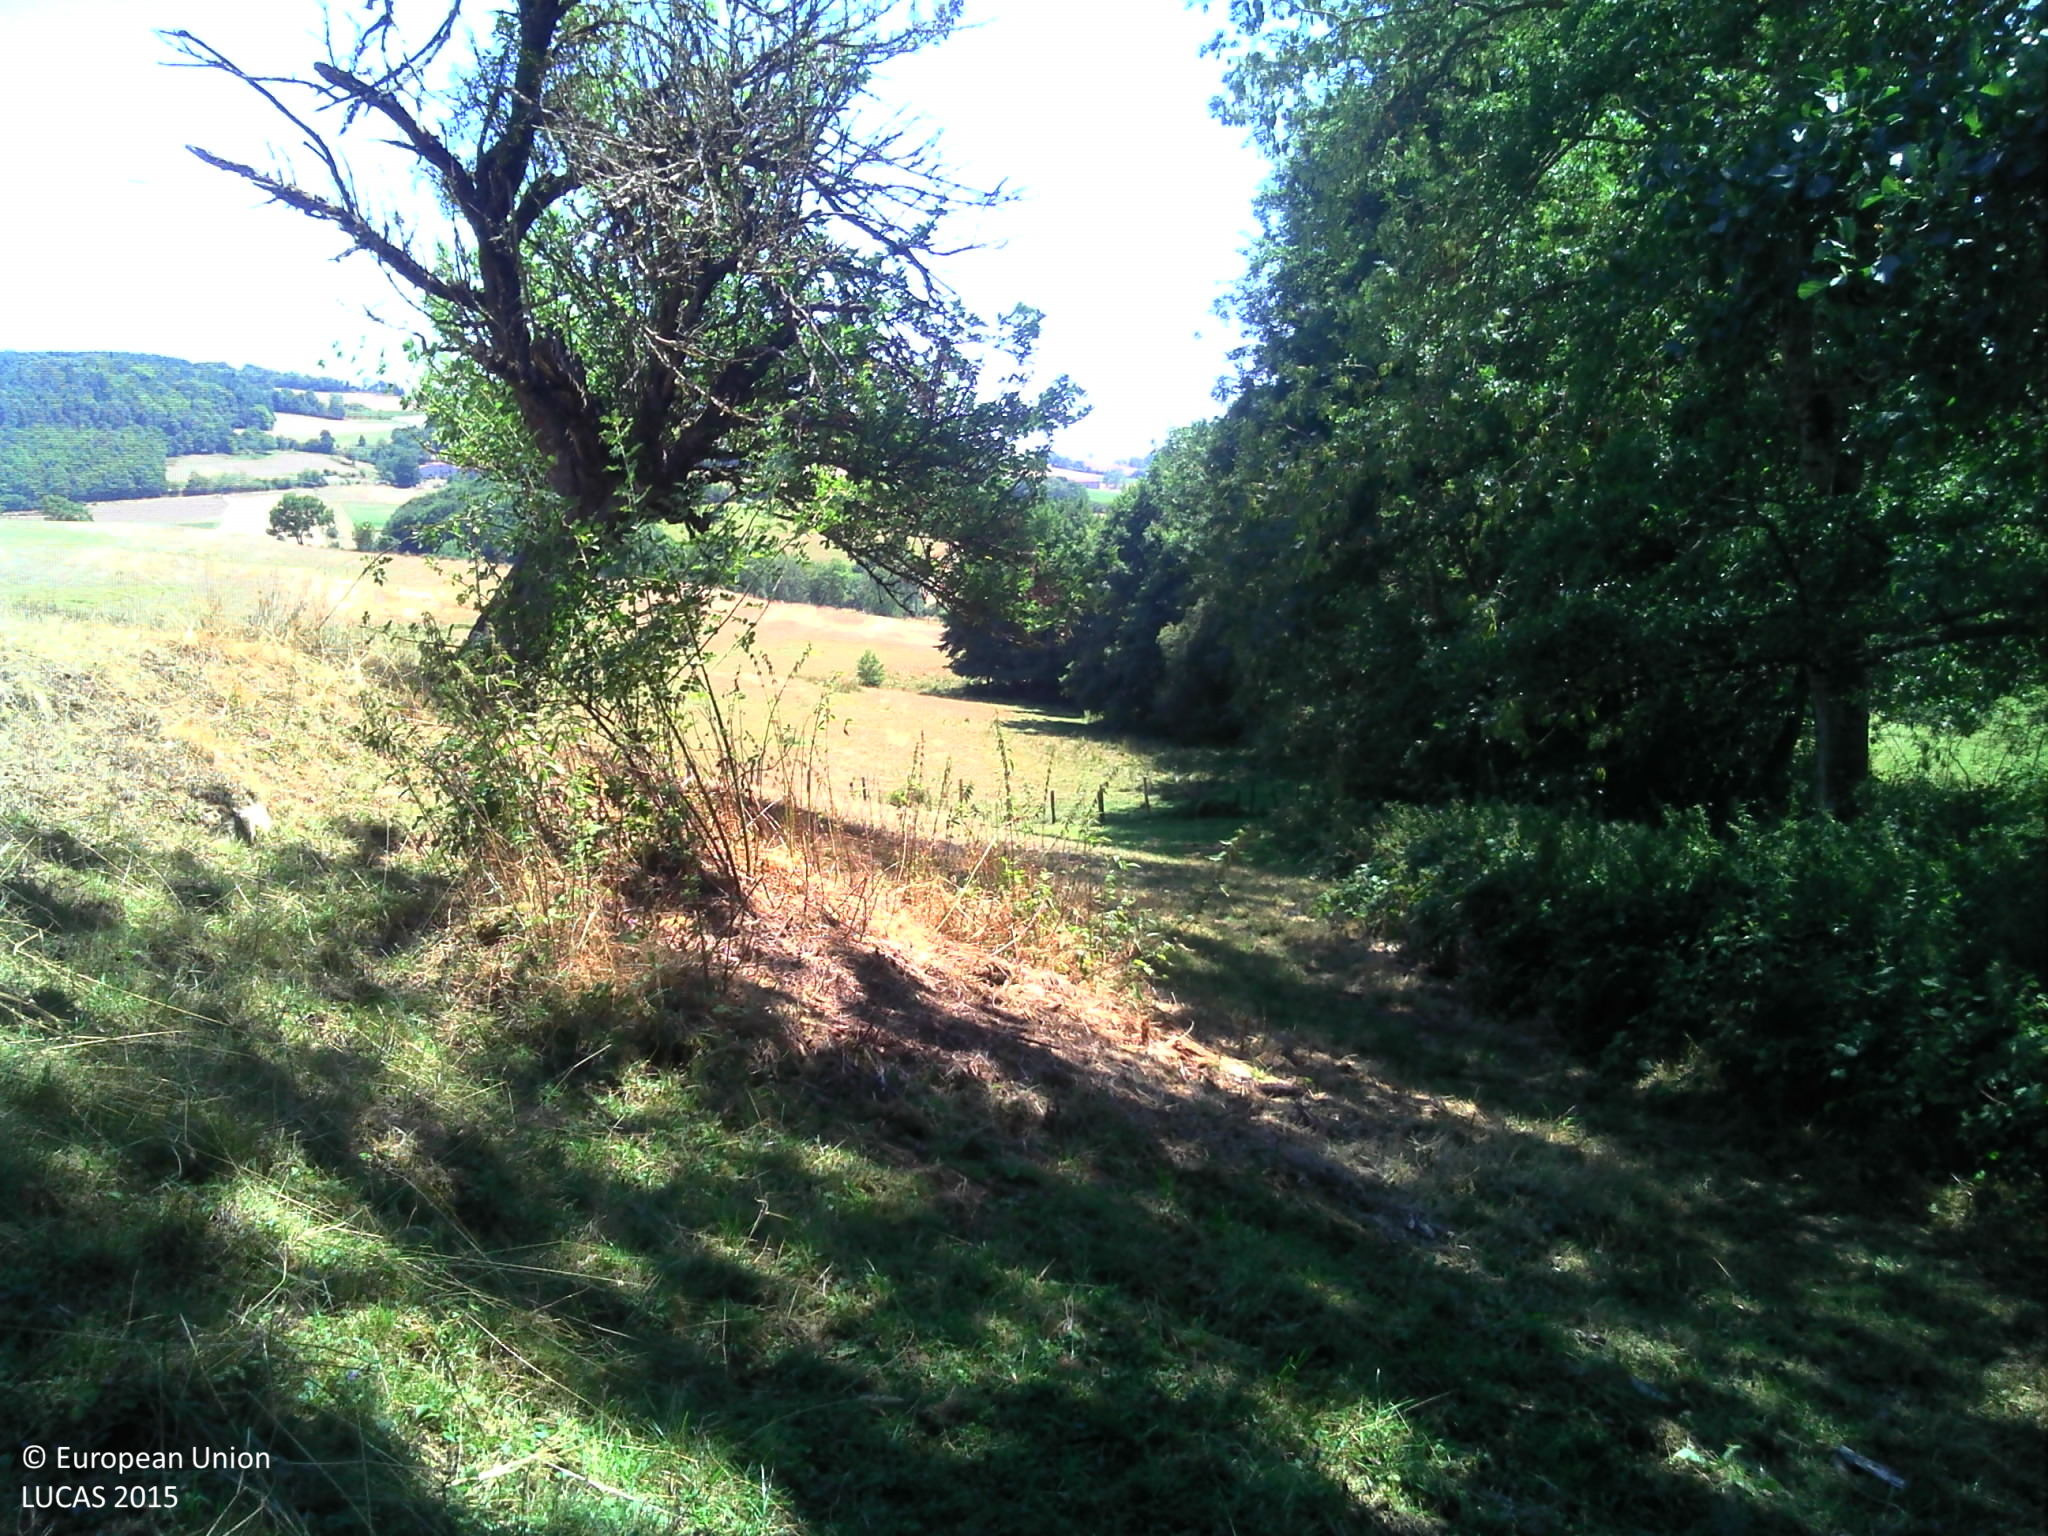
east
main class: Grassland
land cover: Grassland without tree/shrub cover
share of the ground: > 75 %
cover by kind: herbaceous plants 100 %
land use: Agriculture (excluding fallow land and kitchen gardens)
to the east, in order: Grassland without tree/shrub cover; Single bushes/trees; Grassland without tree/shrub cover; Fences; Grassland without tree/shrub cover; Electric lines; Grassland without tree/shrub cover
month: August
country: FR
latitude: 45.6885
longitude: 4.5461
